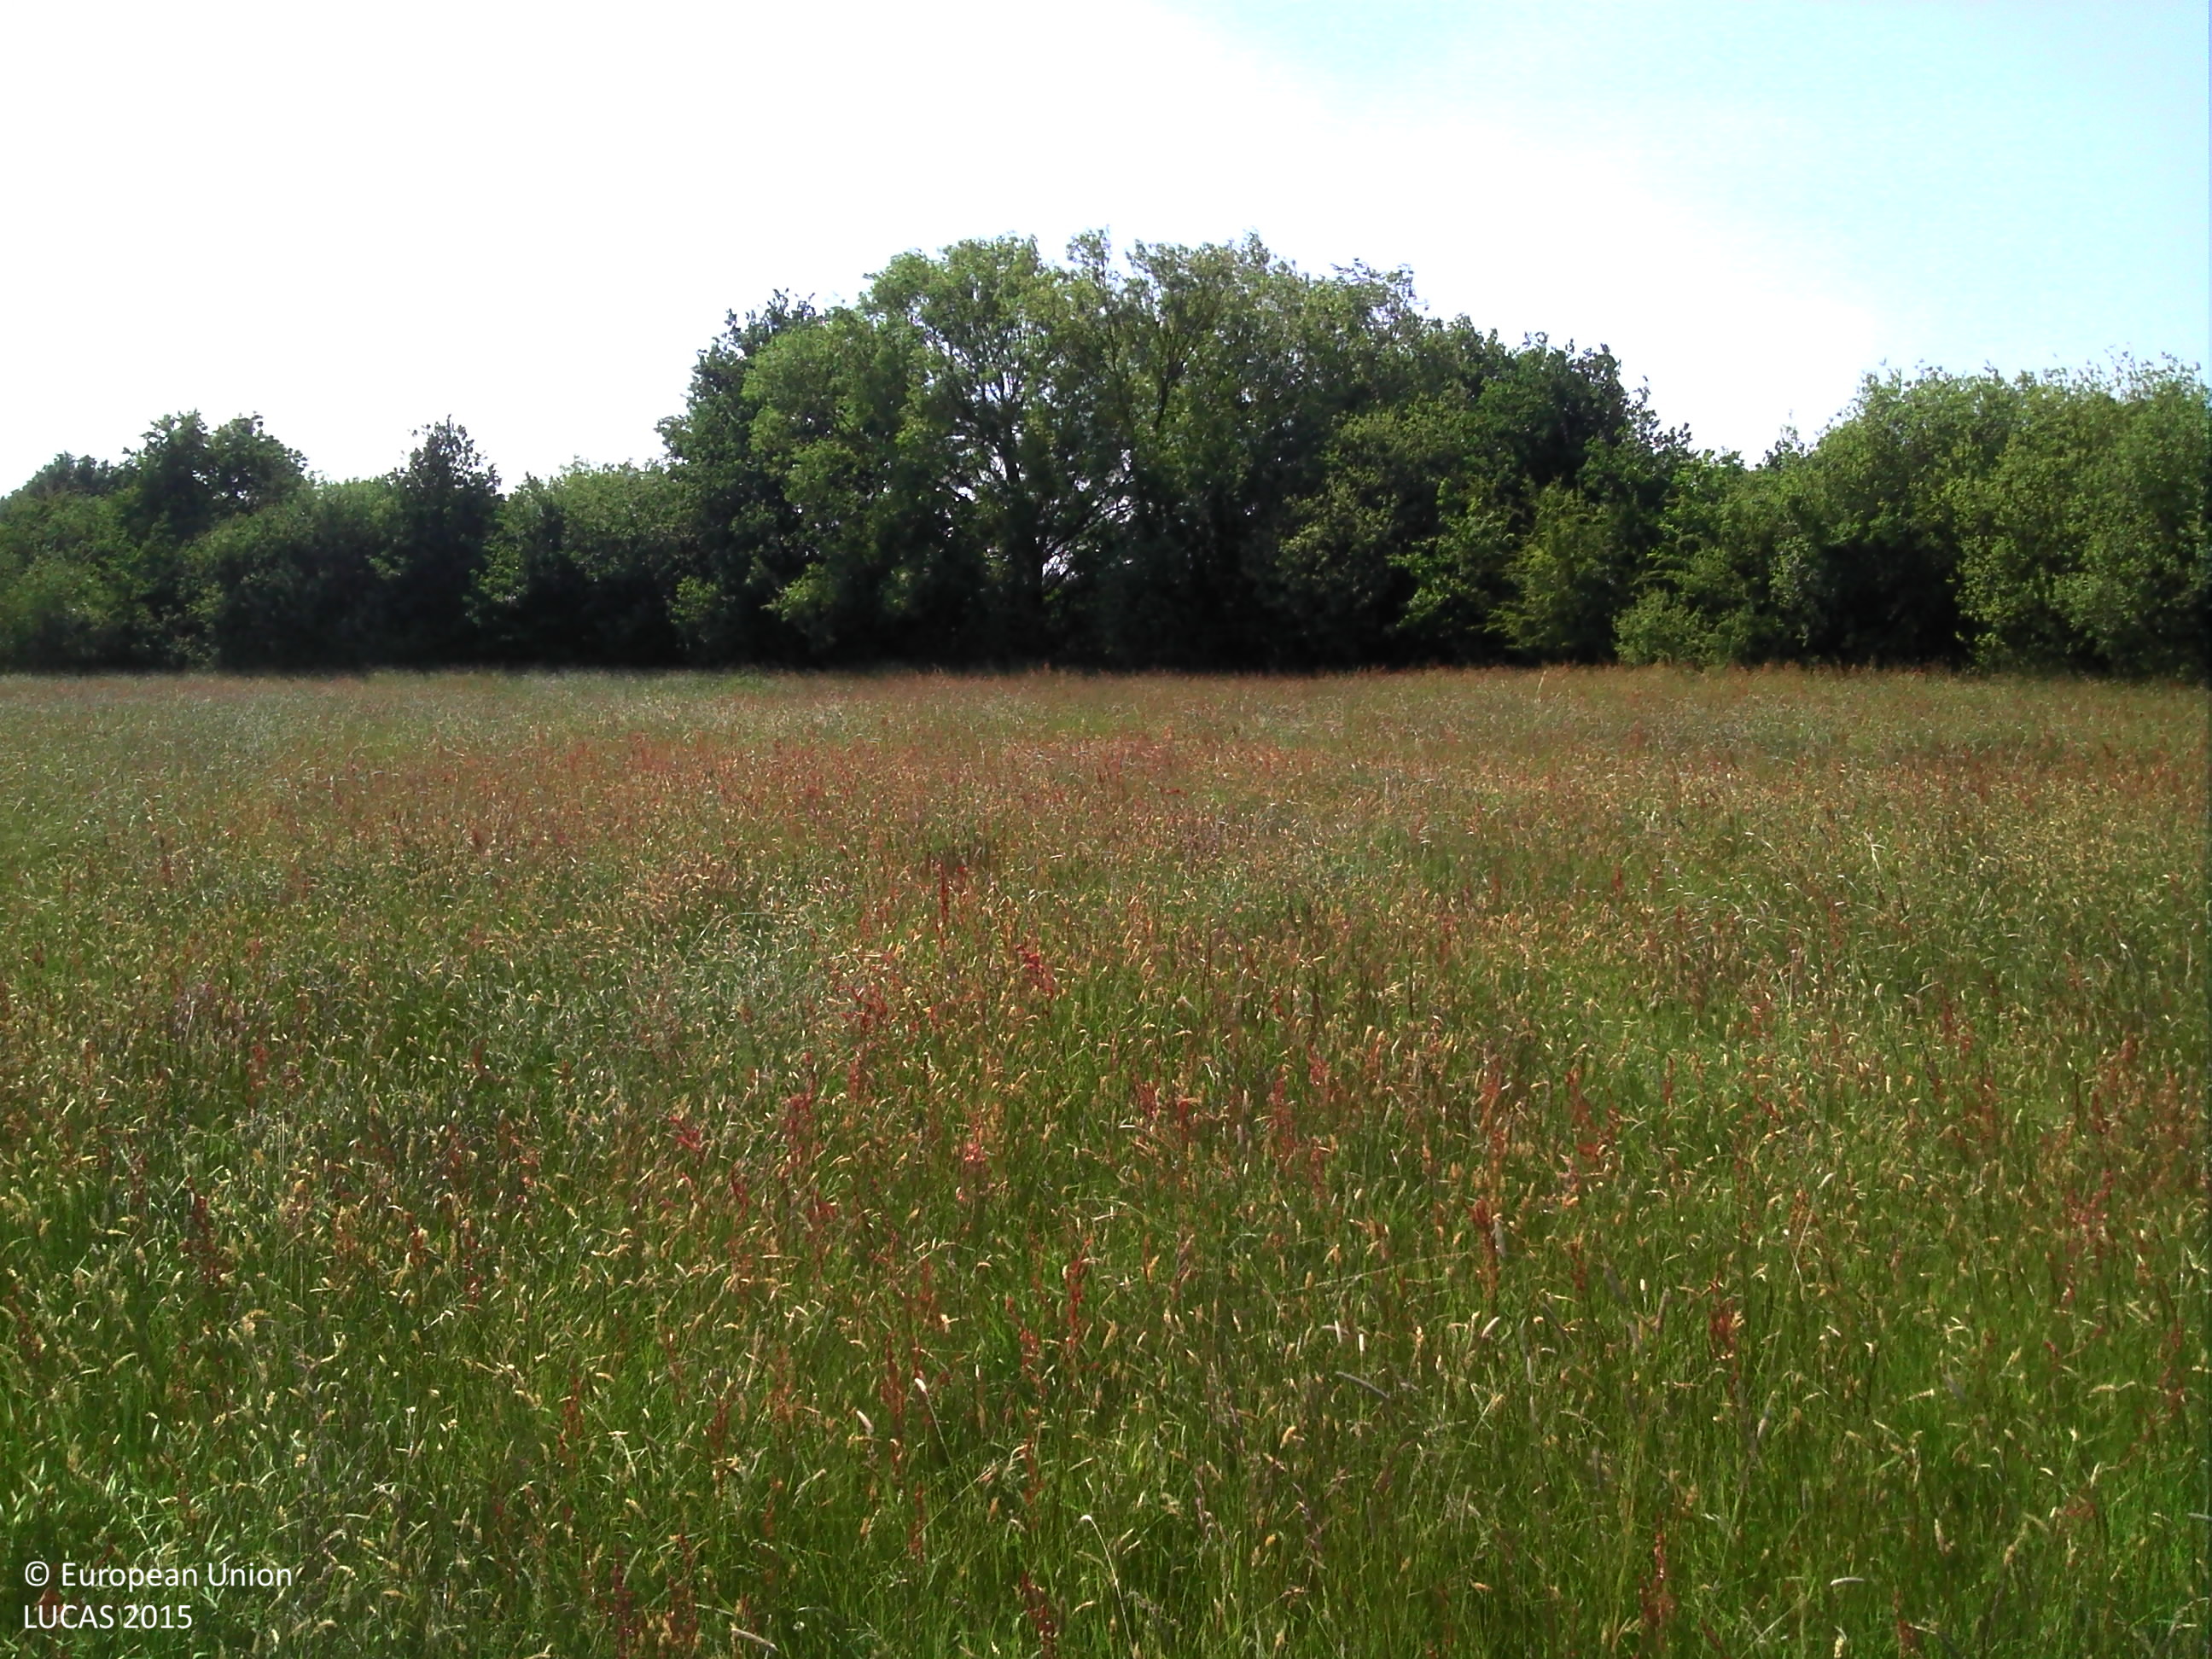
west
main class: Grassland
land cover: Grassland without tree/shrub cover
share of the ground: > 75 %
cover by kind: herbaceous plants 100 %
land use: Agriculture (excluding fallow land and kitchen gardens)
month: June
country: BE
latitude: 50.9646
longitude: 5.1705
